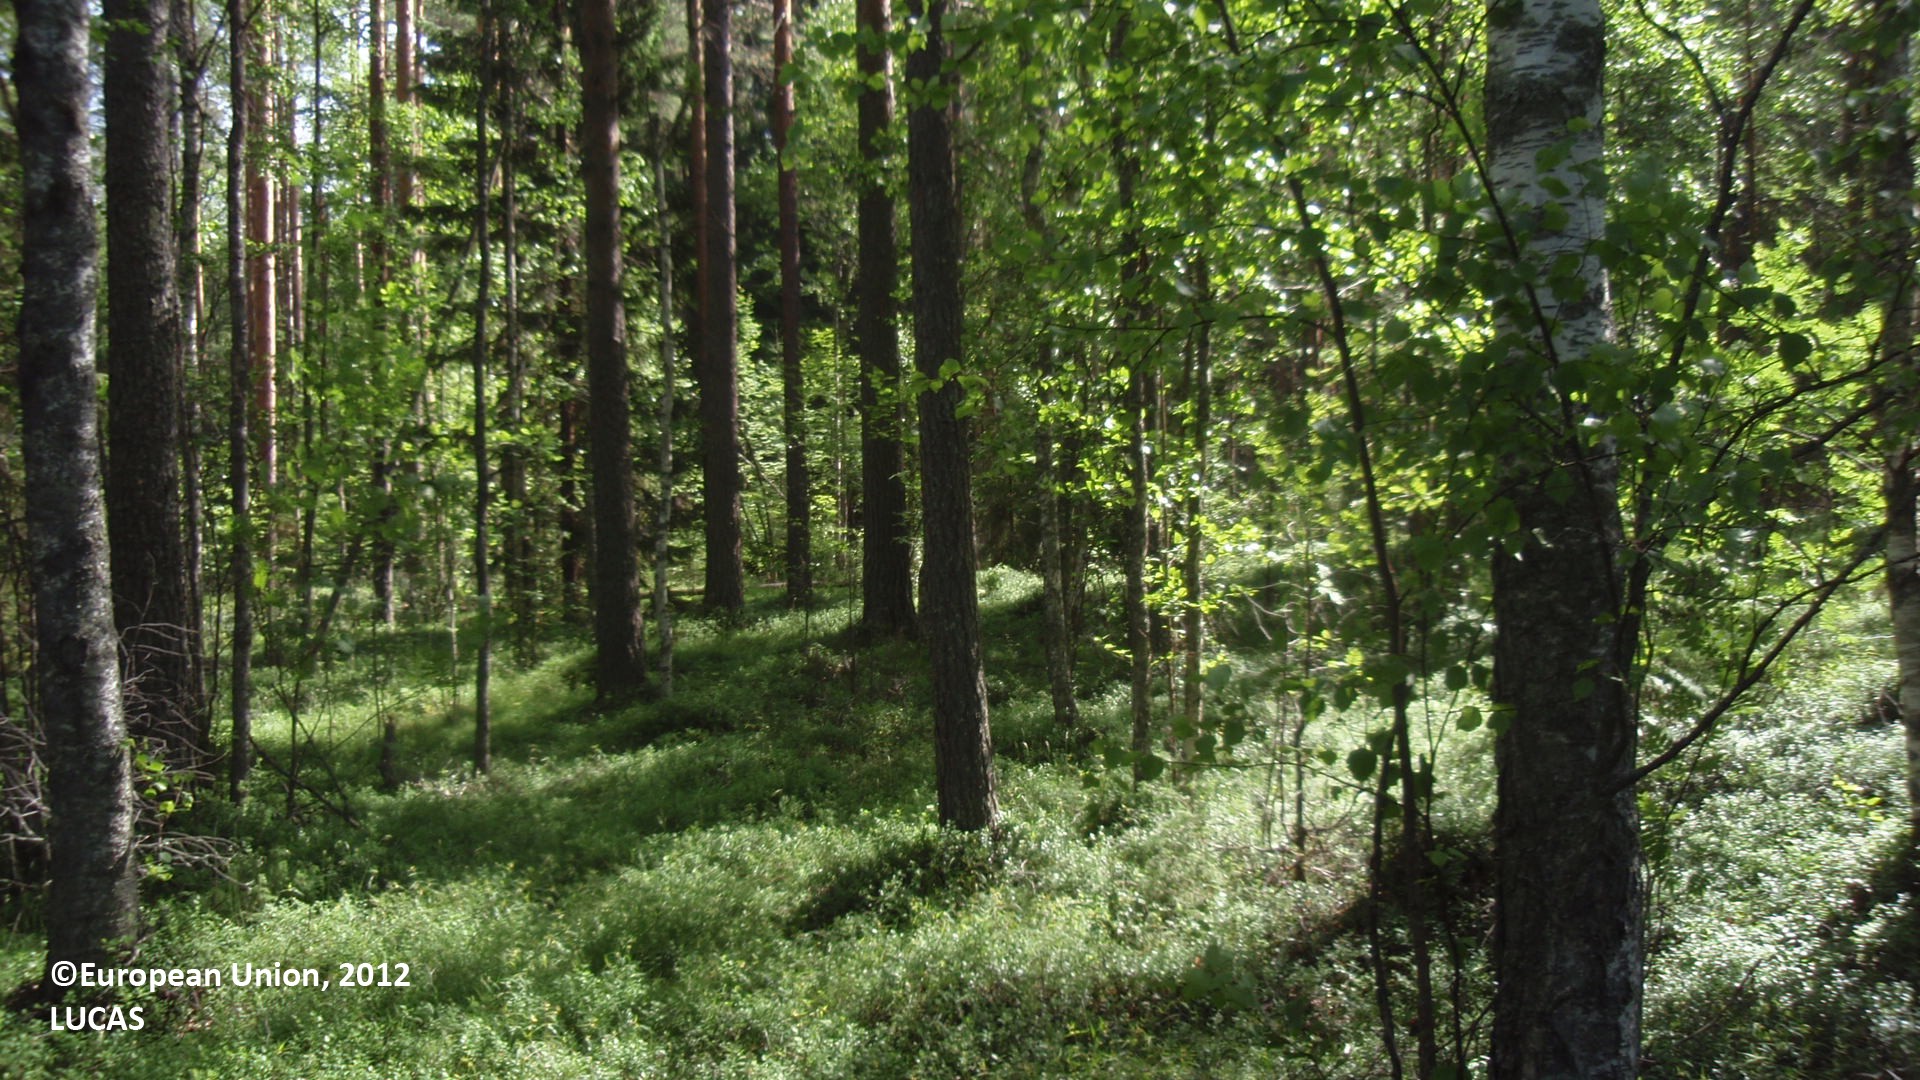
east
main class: Woodland
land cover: Pine dominated mixed woodland
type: boreal forest
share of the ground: 25 - 50 %
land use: Forestry
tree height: > 5 m
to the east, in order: Pine dominated mixed woodland; Pine dominated coniferous woodland; Spruce dominated coniferous woodland; Pine dominated coniferous woodland
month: July
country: FI
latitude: 61.6728
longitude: 28.2032
